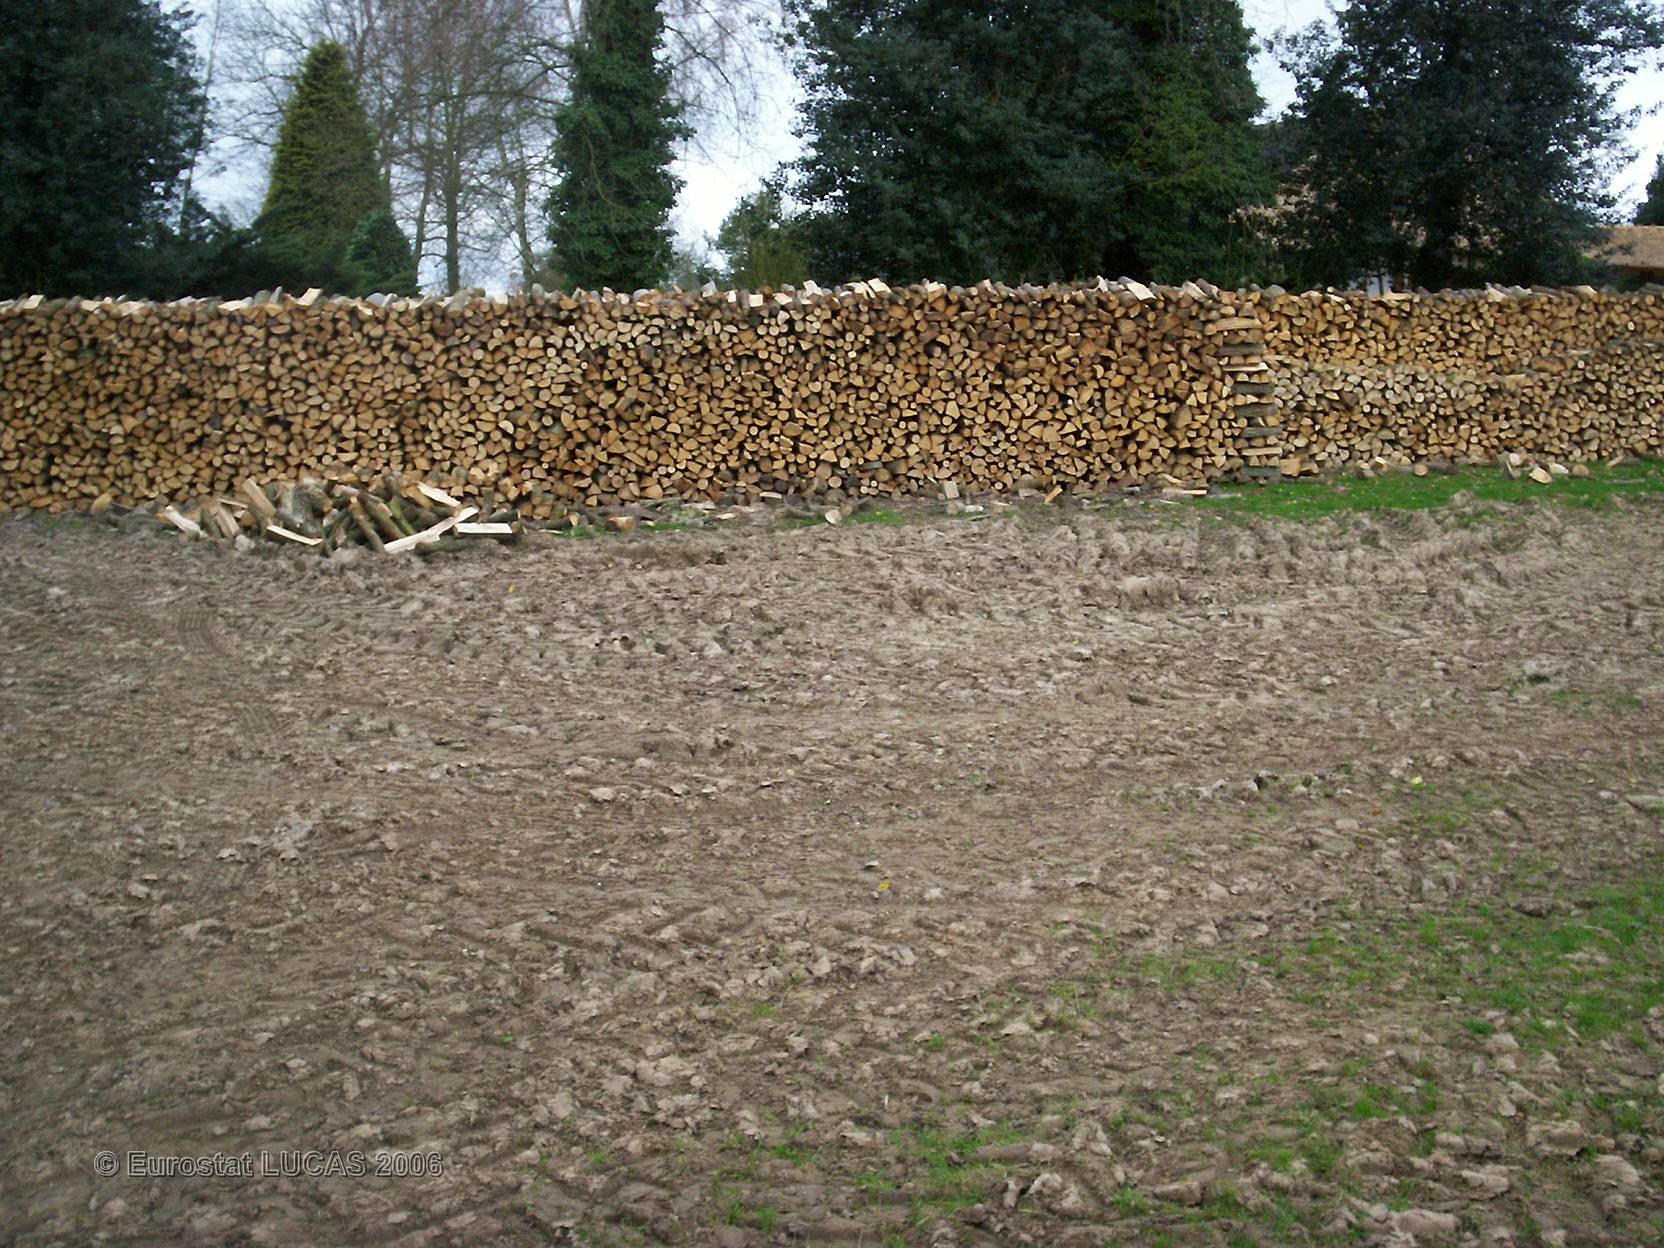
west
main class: Grassland
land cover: Grassland without tree/shrub cover
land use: Agriculture (excluding fallow land and kitchen gardens)
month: April
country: FR
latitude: 49.4988
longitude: 0.9610
